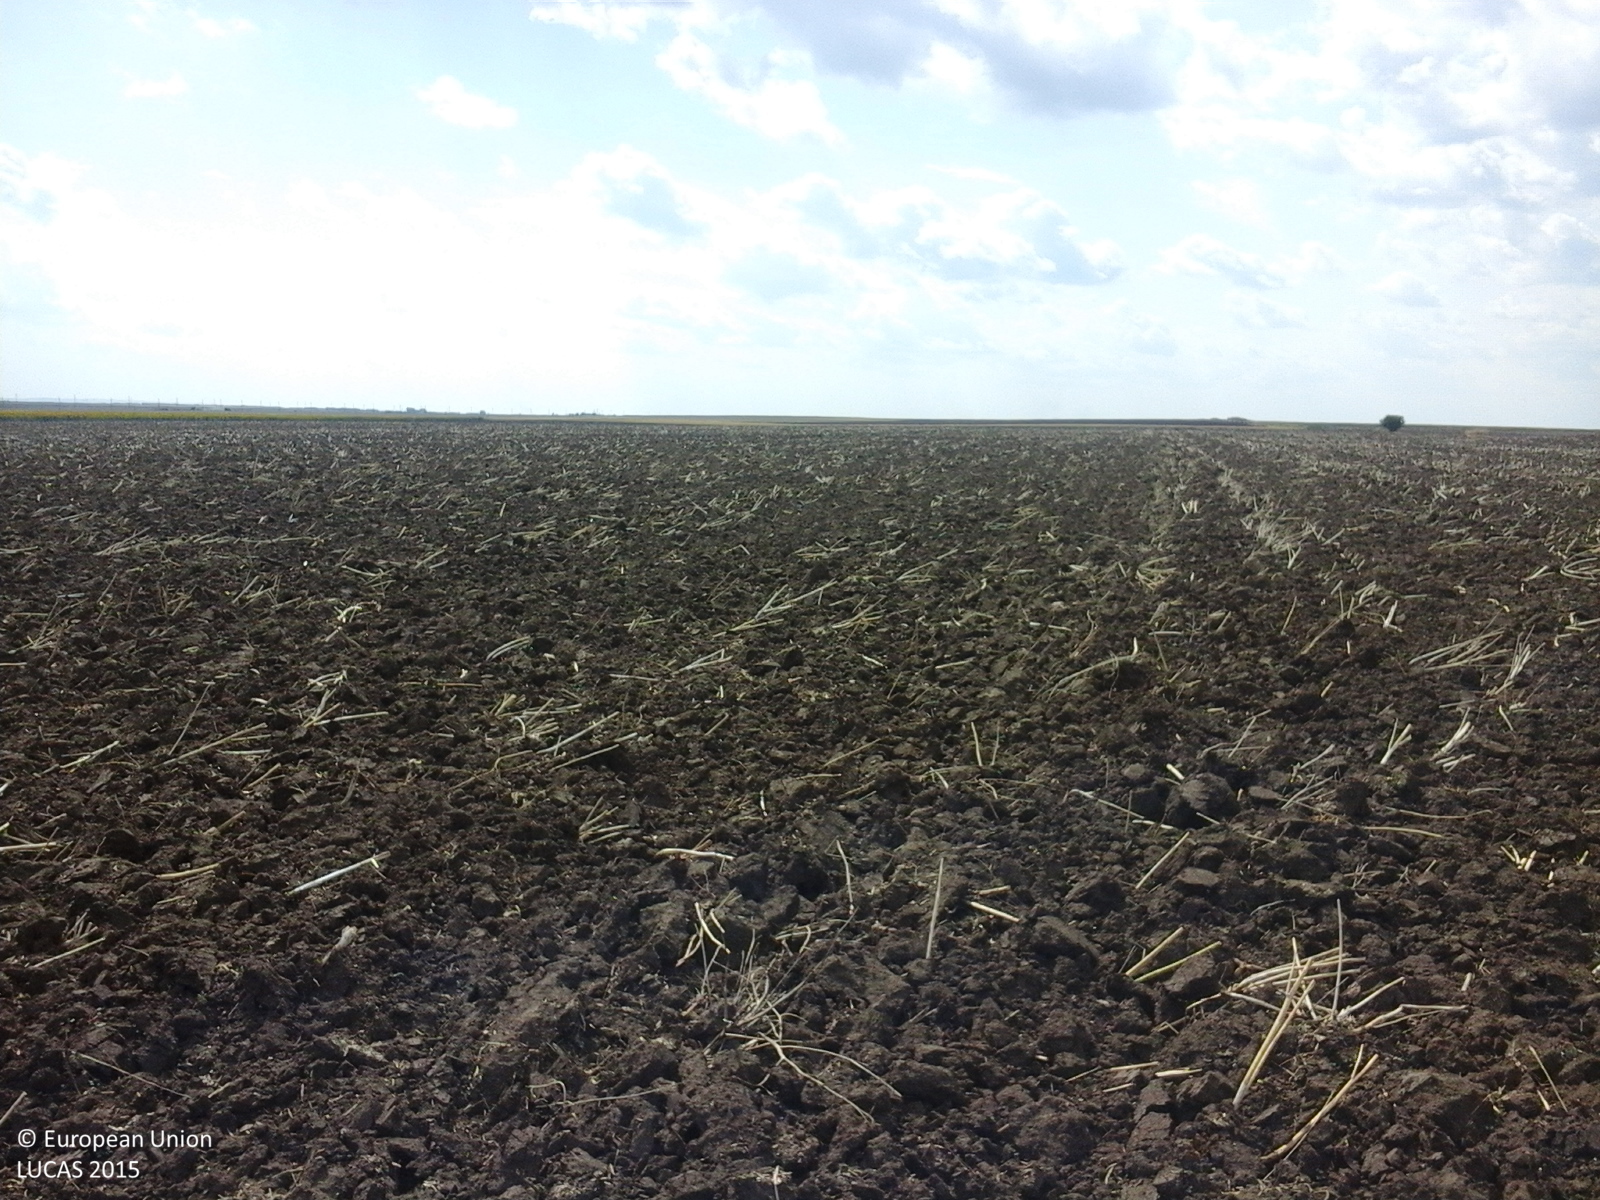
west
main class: Cropland
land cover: Rape and turnip rape
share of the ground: < 10 %
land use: Agriculture (excluding fallow land and kitchen gardens)
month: July
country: RO
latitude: 43.8088
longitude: 24.3197
